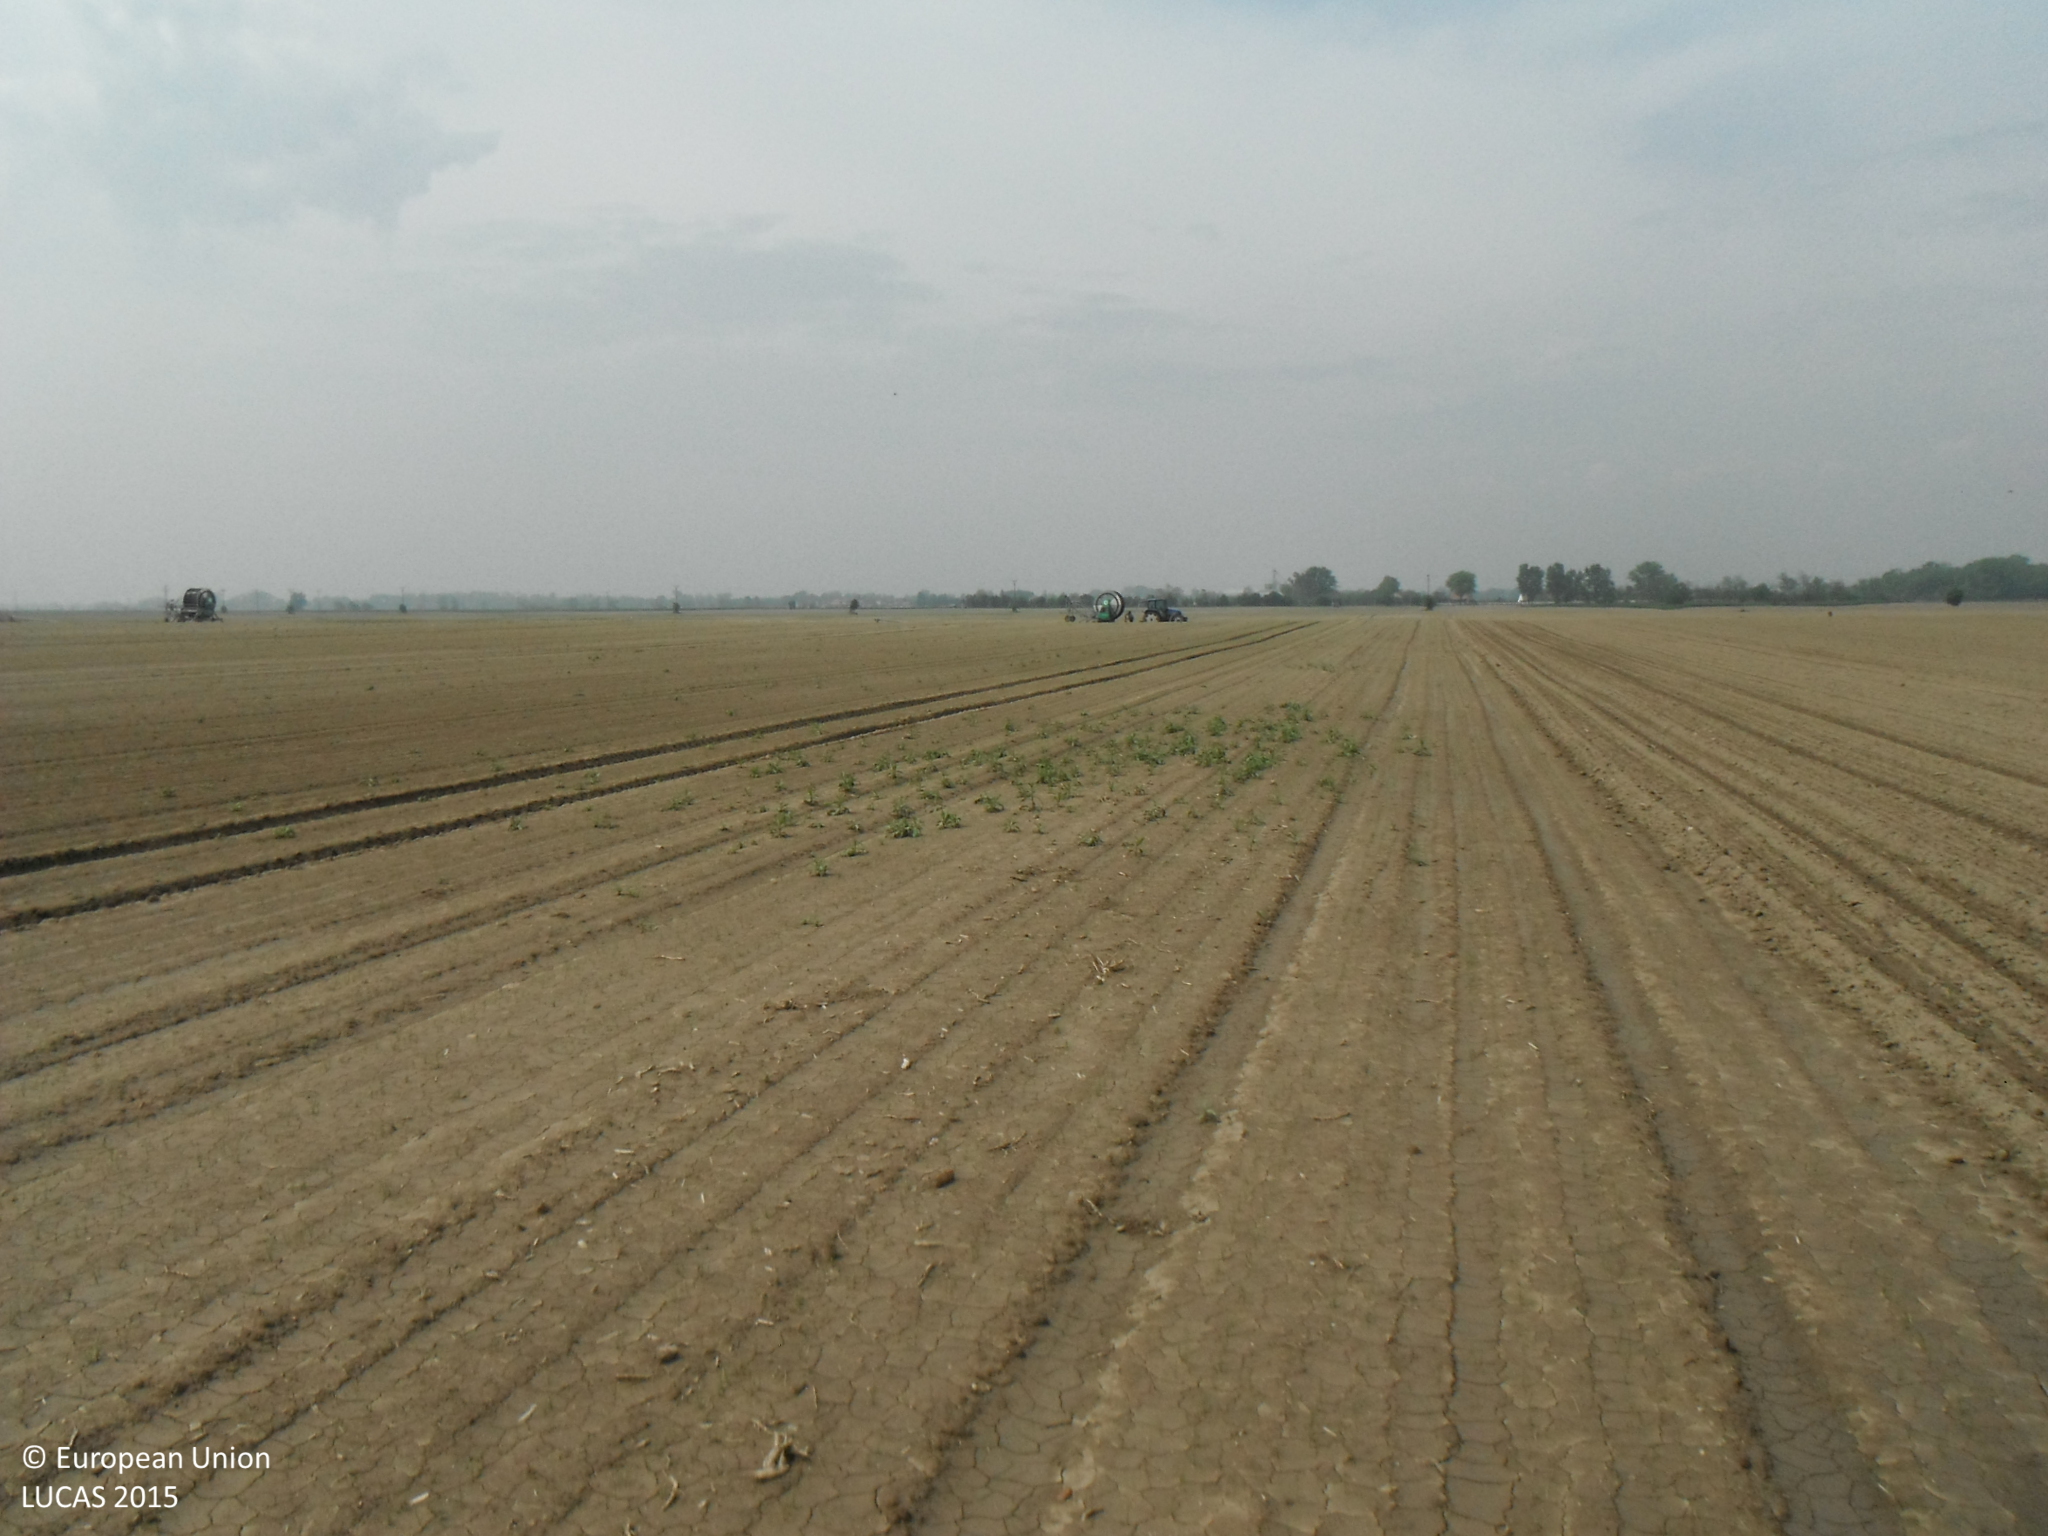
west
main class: Cropland
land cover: Other fresh vegetables
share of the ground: < 10 %
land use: Agriculture (excluding fallow land and kitchen gardens)
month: May
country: SK
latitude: 48.1561
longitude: 17.3896
